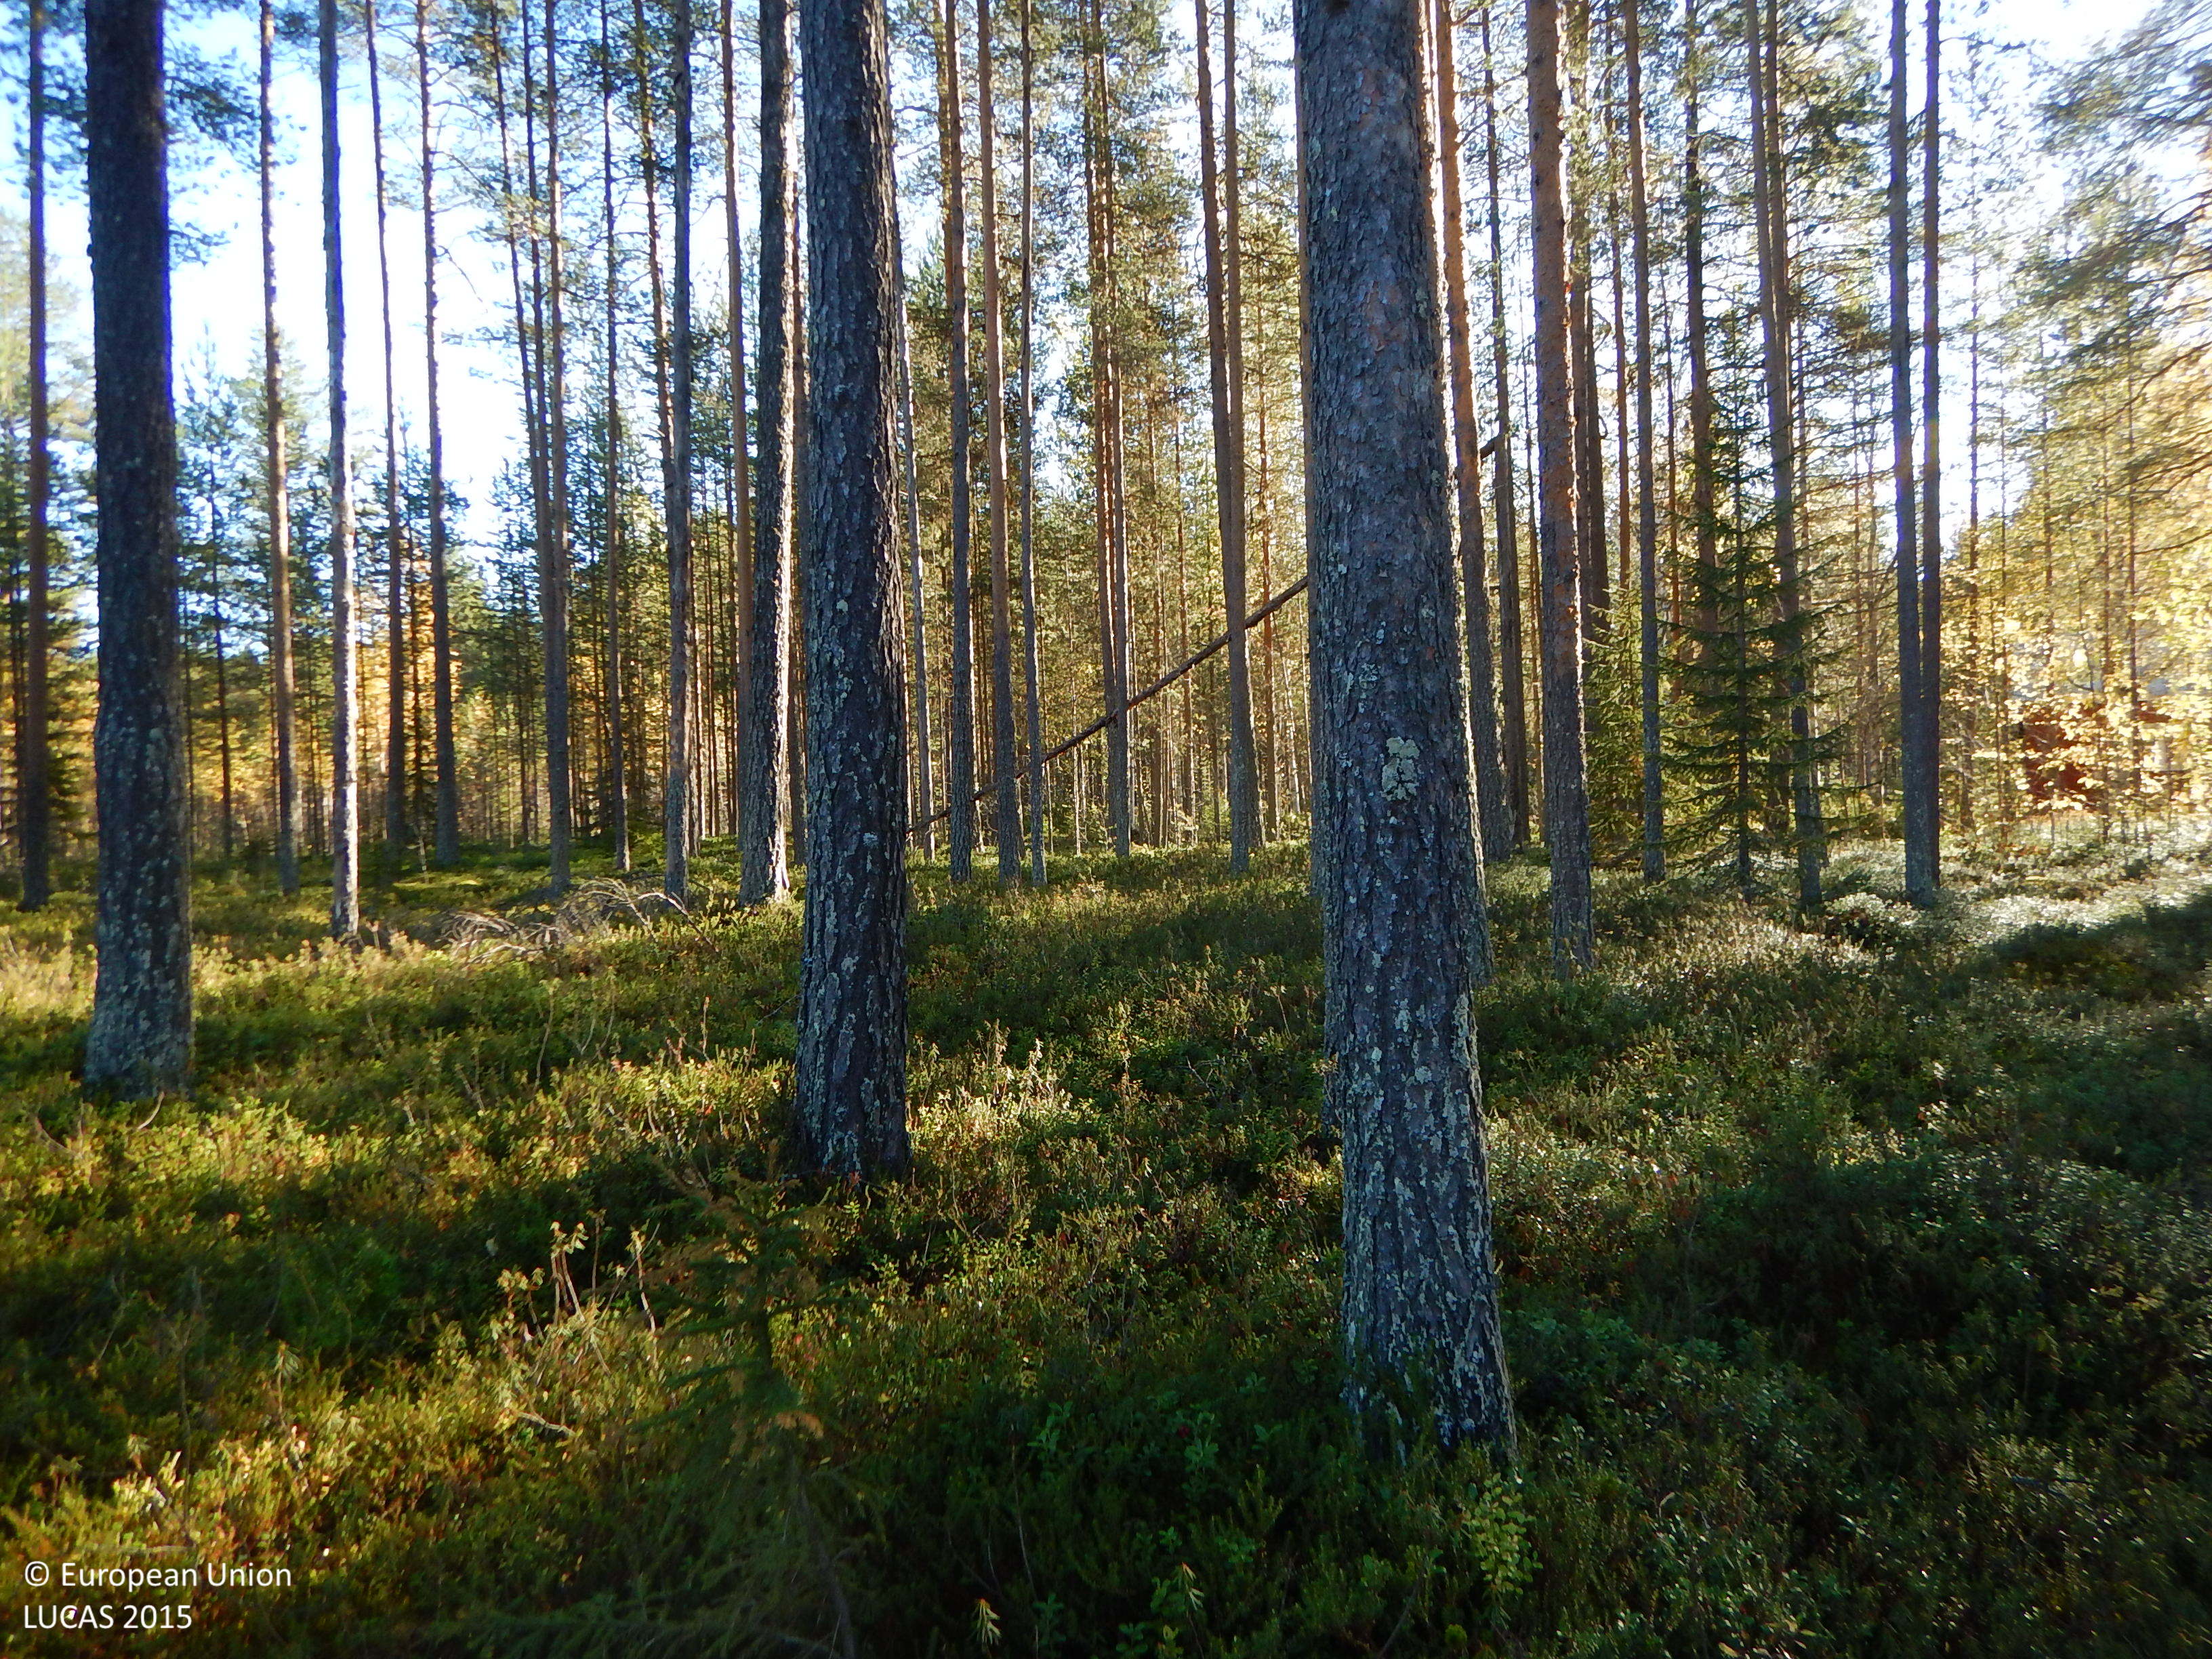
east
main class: Woodland
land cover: Pine dominated coniferous woodland
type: boreal forest
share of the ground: 50 - 75 %
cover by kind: coniferous forest trees 50 %, lichens and mosses 20 %, shrubs 15 %, herbaceous plants 10 %, broadleaved forest trees 5 %
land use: Forestry
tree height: > 5 m
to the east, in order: Pine dominated coniferous woodland; Tracks; Pine dominated mixed woodland; Ditches and canals; Paved roads, cycling and walking lanes; Ditches and canals; Pine dominated mixed woodland; Ditches and canals; Pine dominated coniferous woodland; Tracks; Pine dominated coniferous woodland
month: September
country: SE
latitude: 64.9147
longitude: 20.0964
